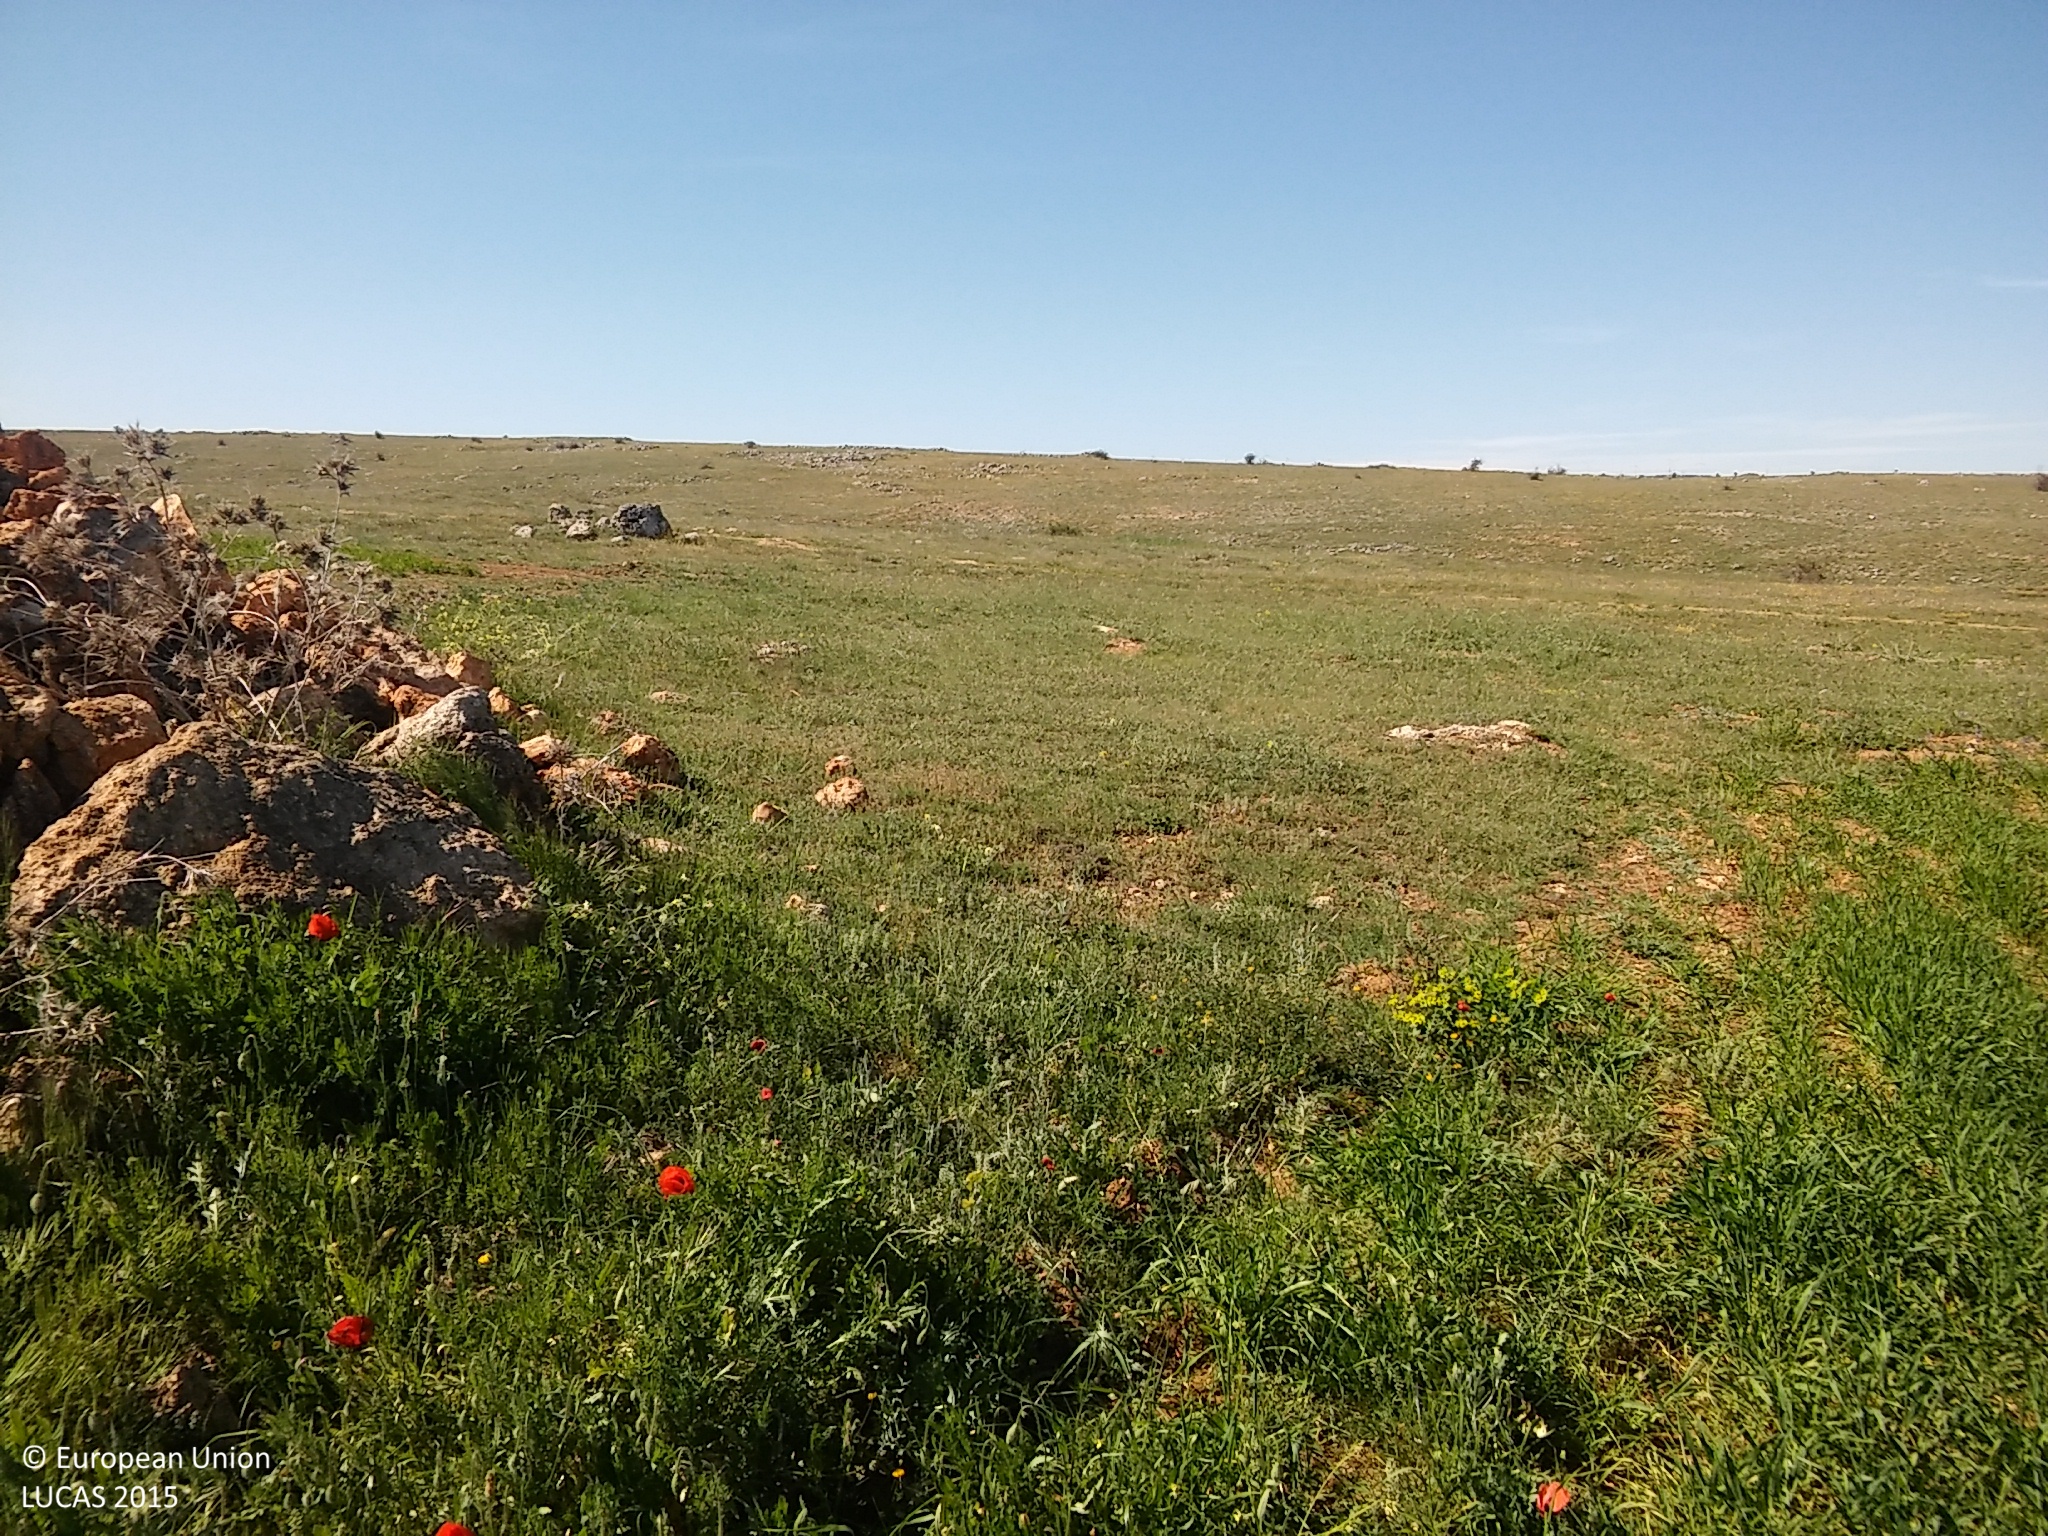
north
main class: Cropland
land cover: Barley
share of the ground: > 75 %
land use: Agriculture (excluding fallow land and kitchen gardens)
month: May
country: ES
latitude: 41.3830
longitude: -3.7420
